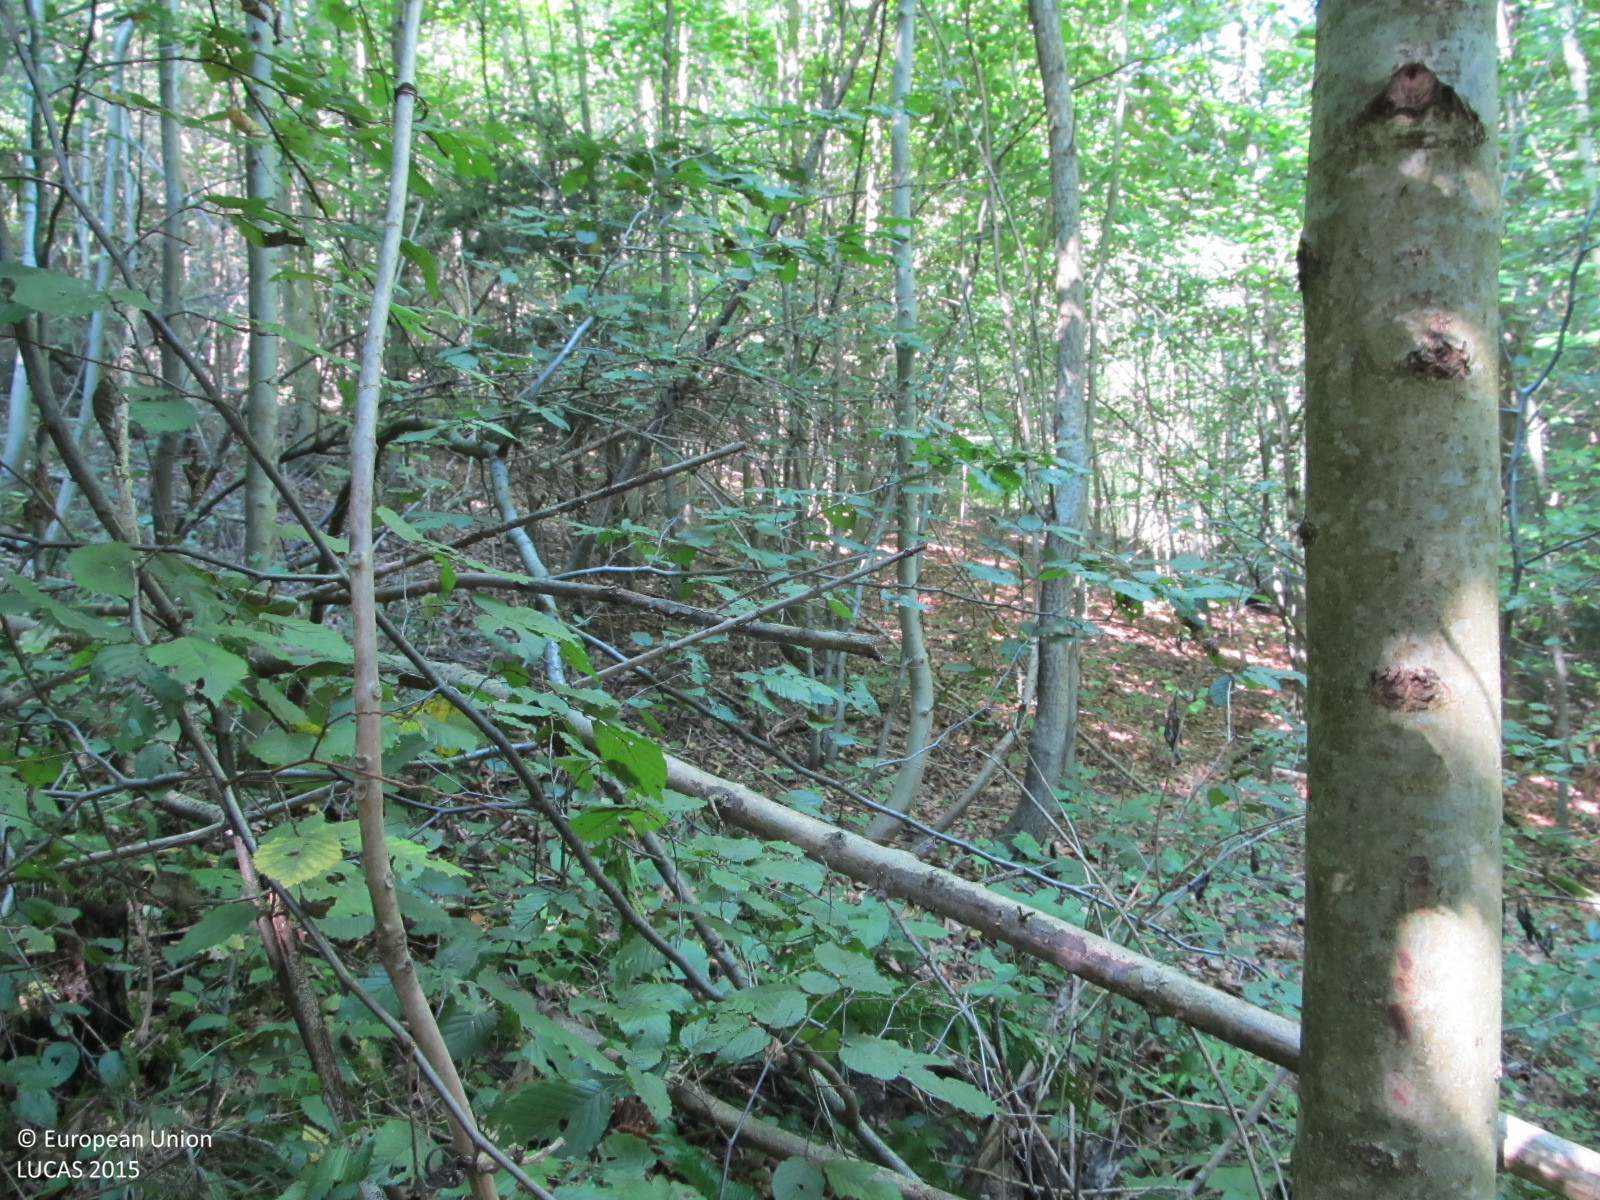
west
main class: Woodland
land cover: Other mixed woodland
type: hemiboreal forest and nemoral coniferous forest and mixed broadleaved-coniferous forest
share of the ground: > 75 %
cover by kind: broadleaved forest trees 55 %, coniferous forest trees 25 %, shrubs 10 %, unconsolidated bare surface 10 %
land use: Forestry
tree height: > 5 m
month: August
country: AT
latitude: 48.5655
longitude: 15.6541
